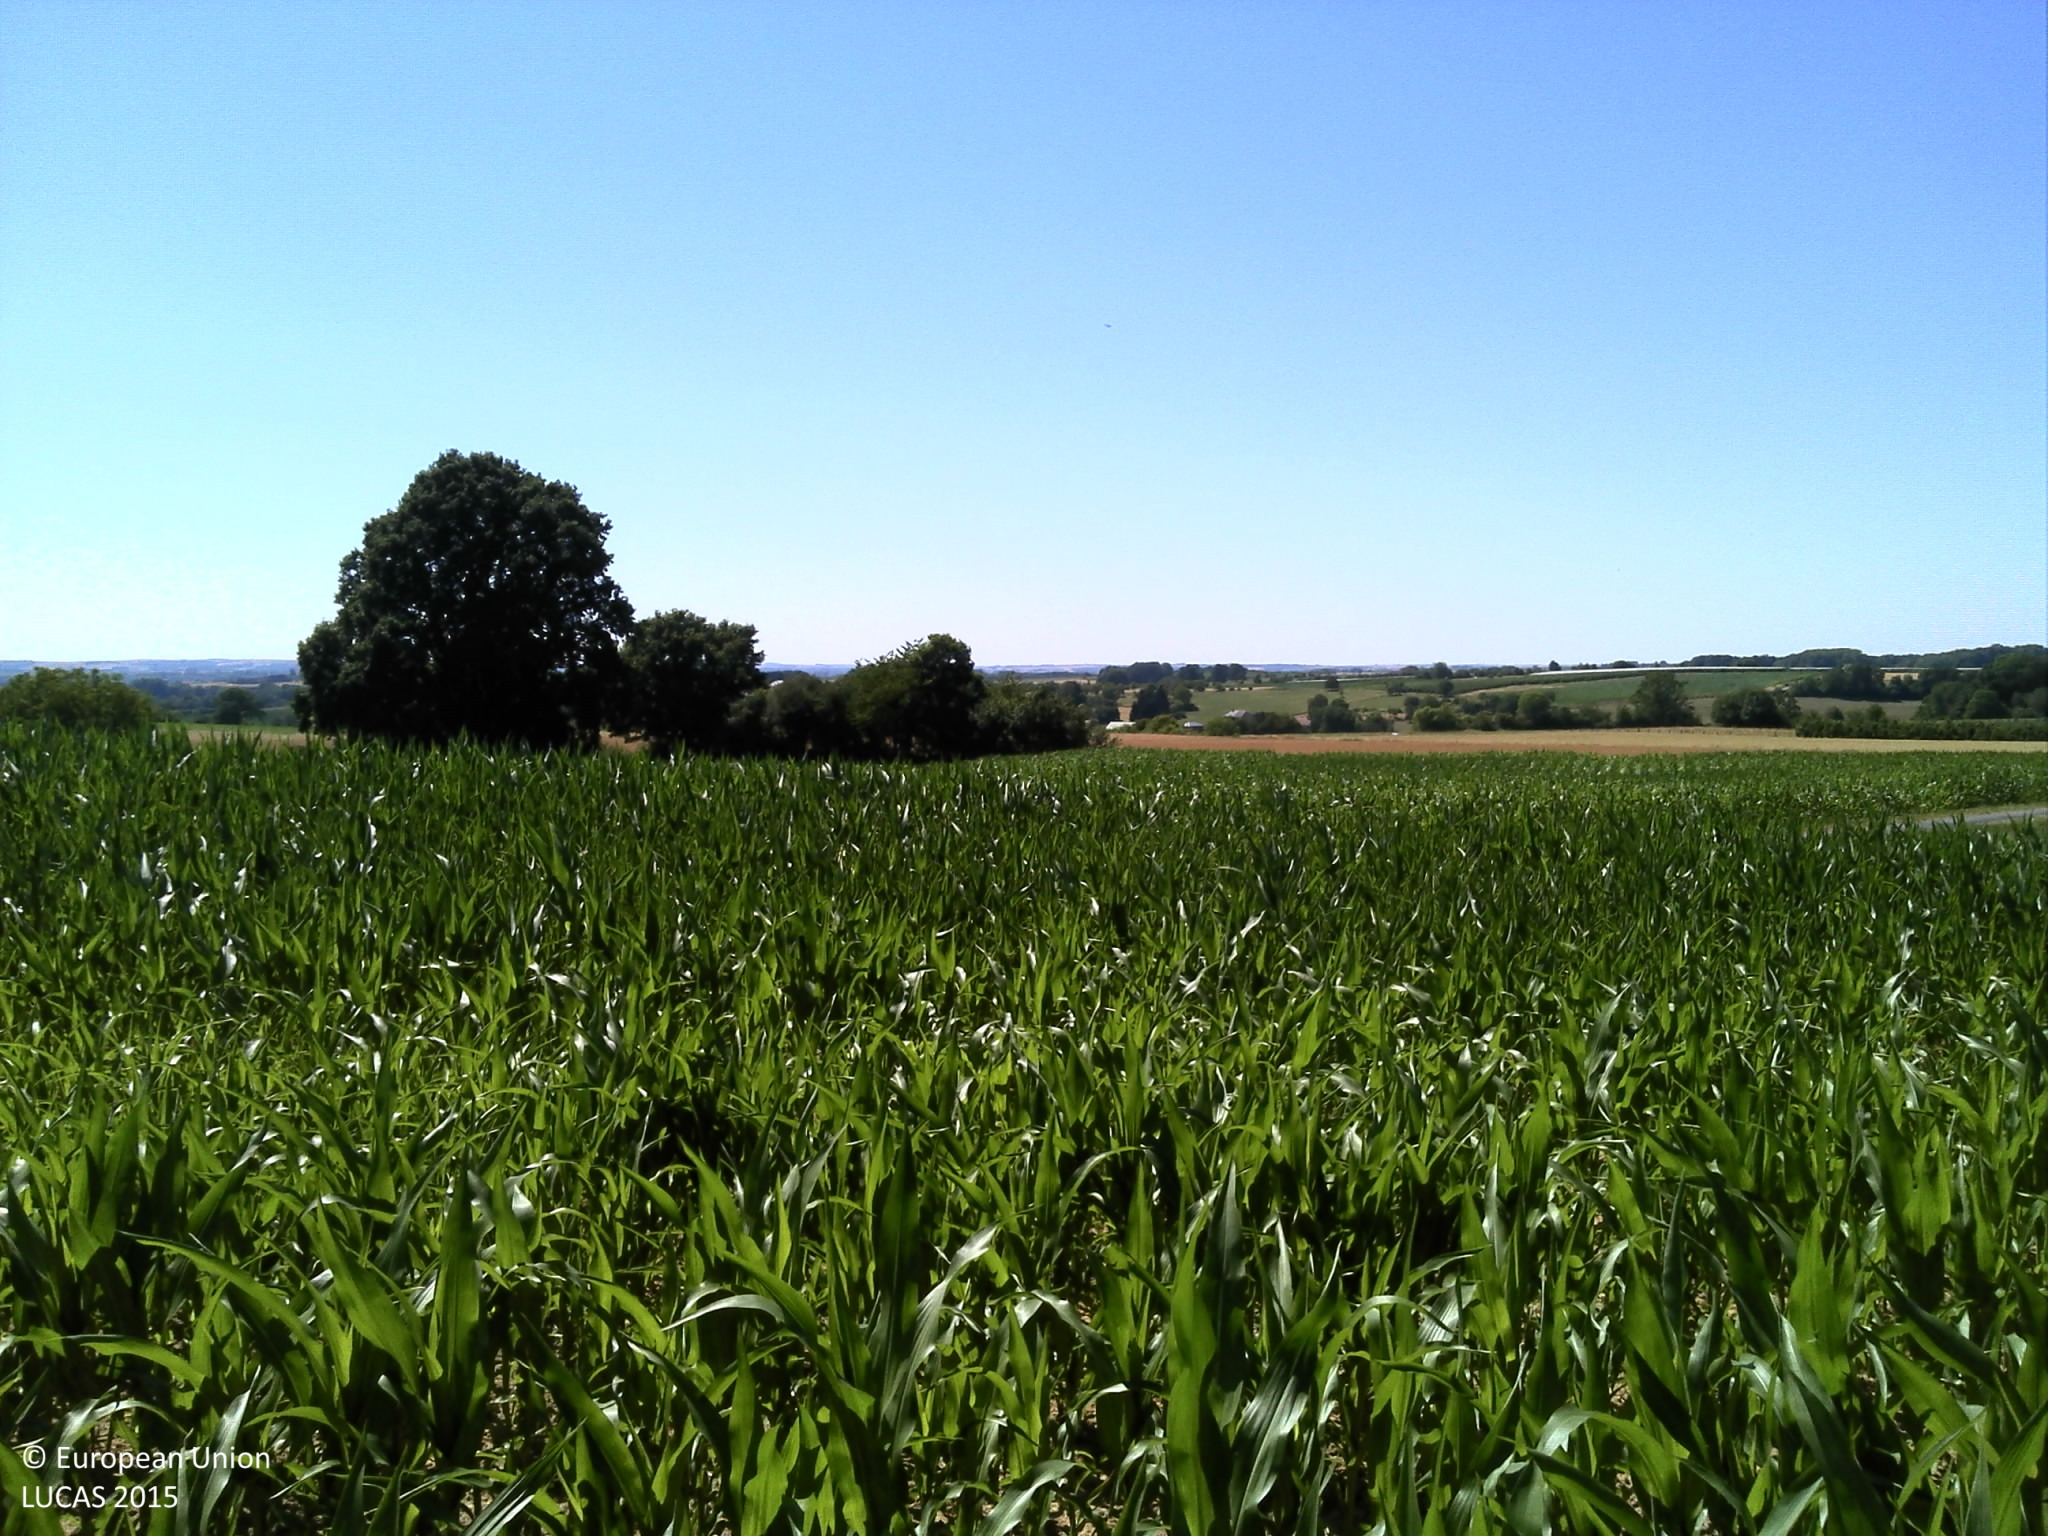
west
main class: Cropland
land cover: Maize
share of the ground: > 75 %
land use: Agriculture (excluding fallow land and kitchen gardens)
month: July
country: FR
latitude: 49.5180
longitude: 4.6510
